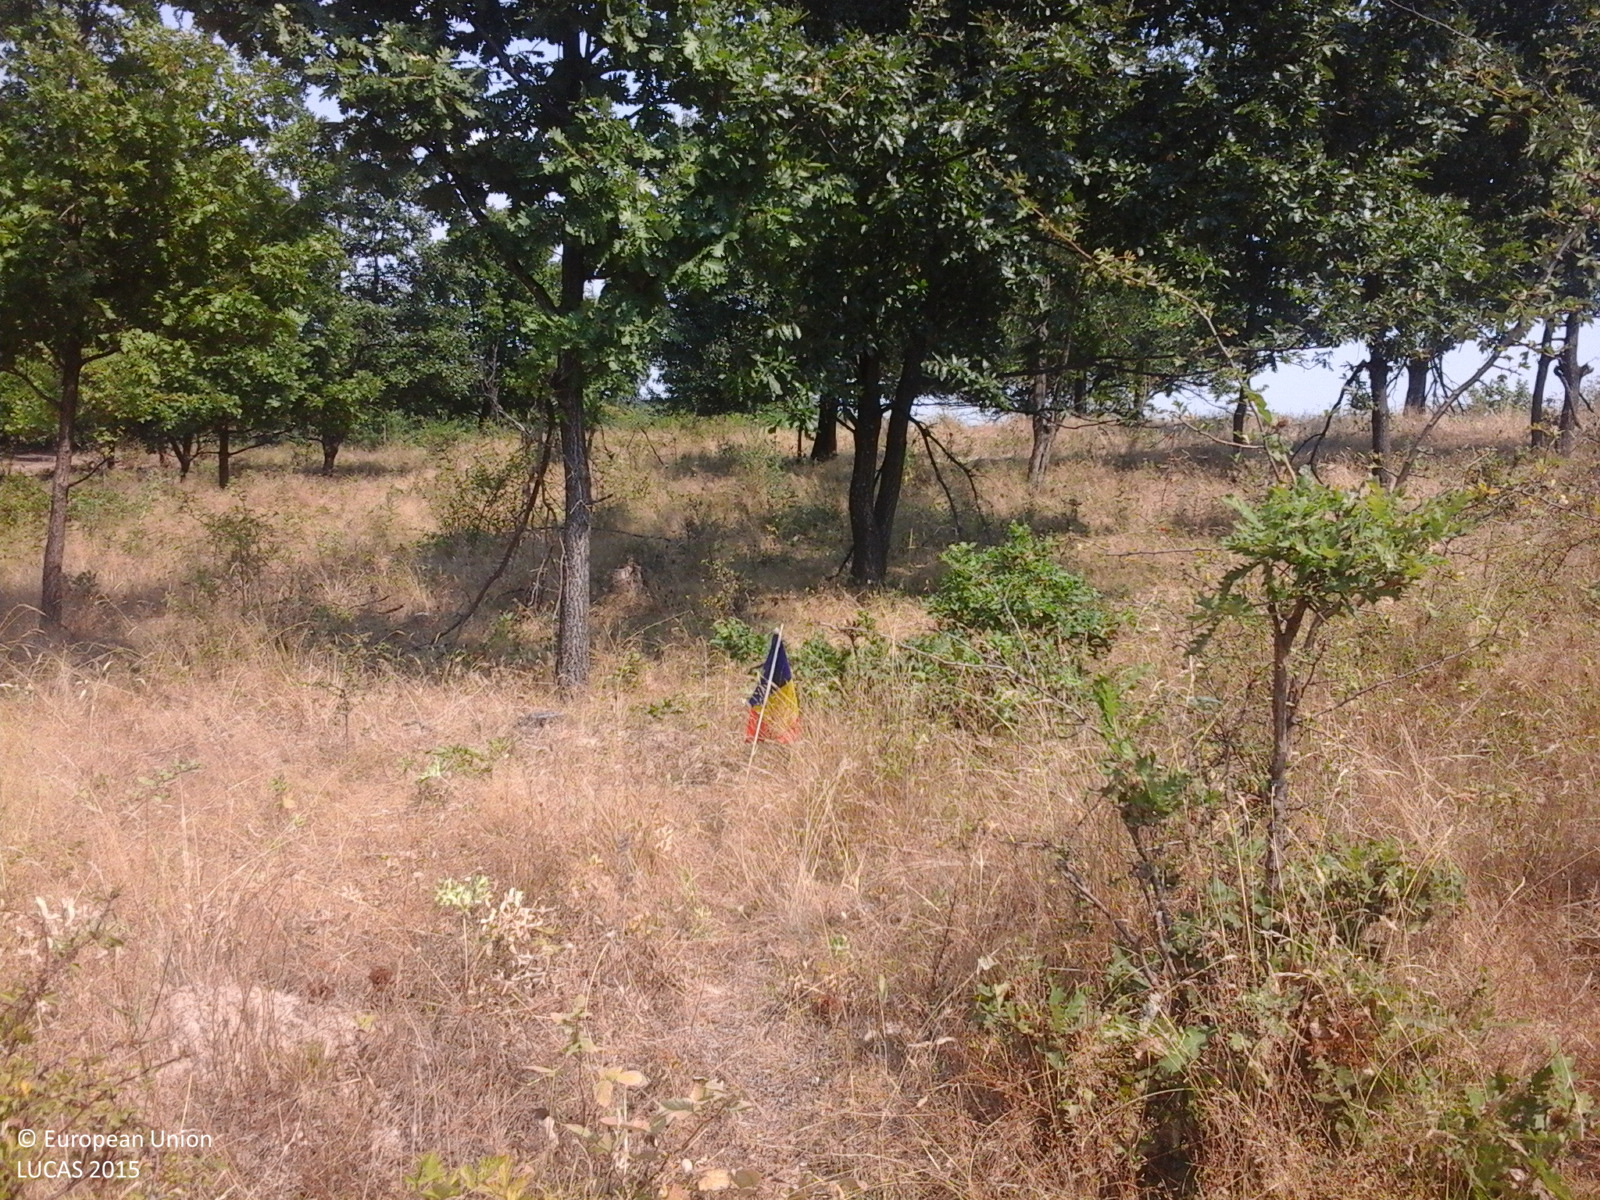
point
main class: Grassland
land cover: Grassland with sparse tree/shrub cover
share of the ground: > 75 %
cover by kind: herbaceous plants 85 %, shrubs 10 %, broadleaved forest trees 5 %
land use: Agriculture (excluding fallow land and kitchen gardens)
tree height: > 5 m
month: August
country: RO
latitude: 44.6009
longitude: 23.0361
